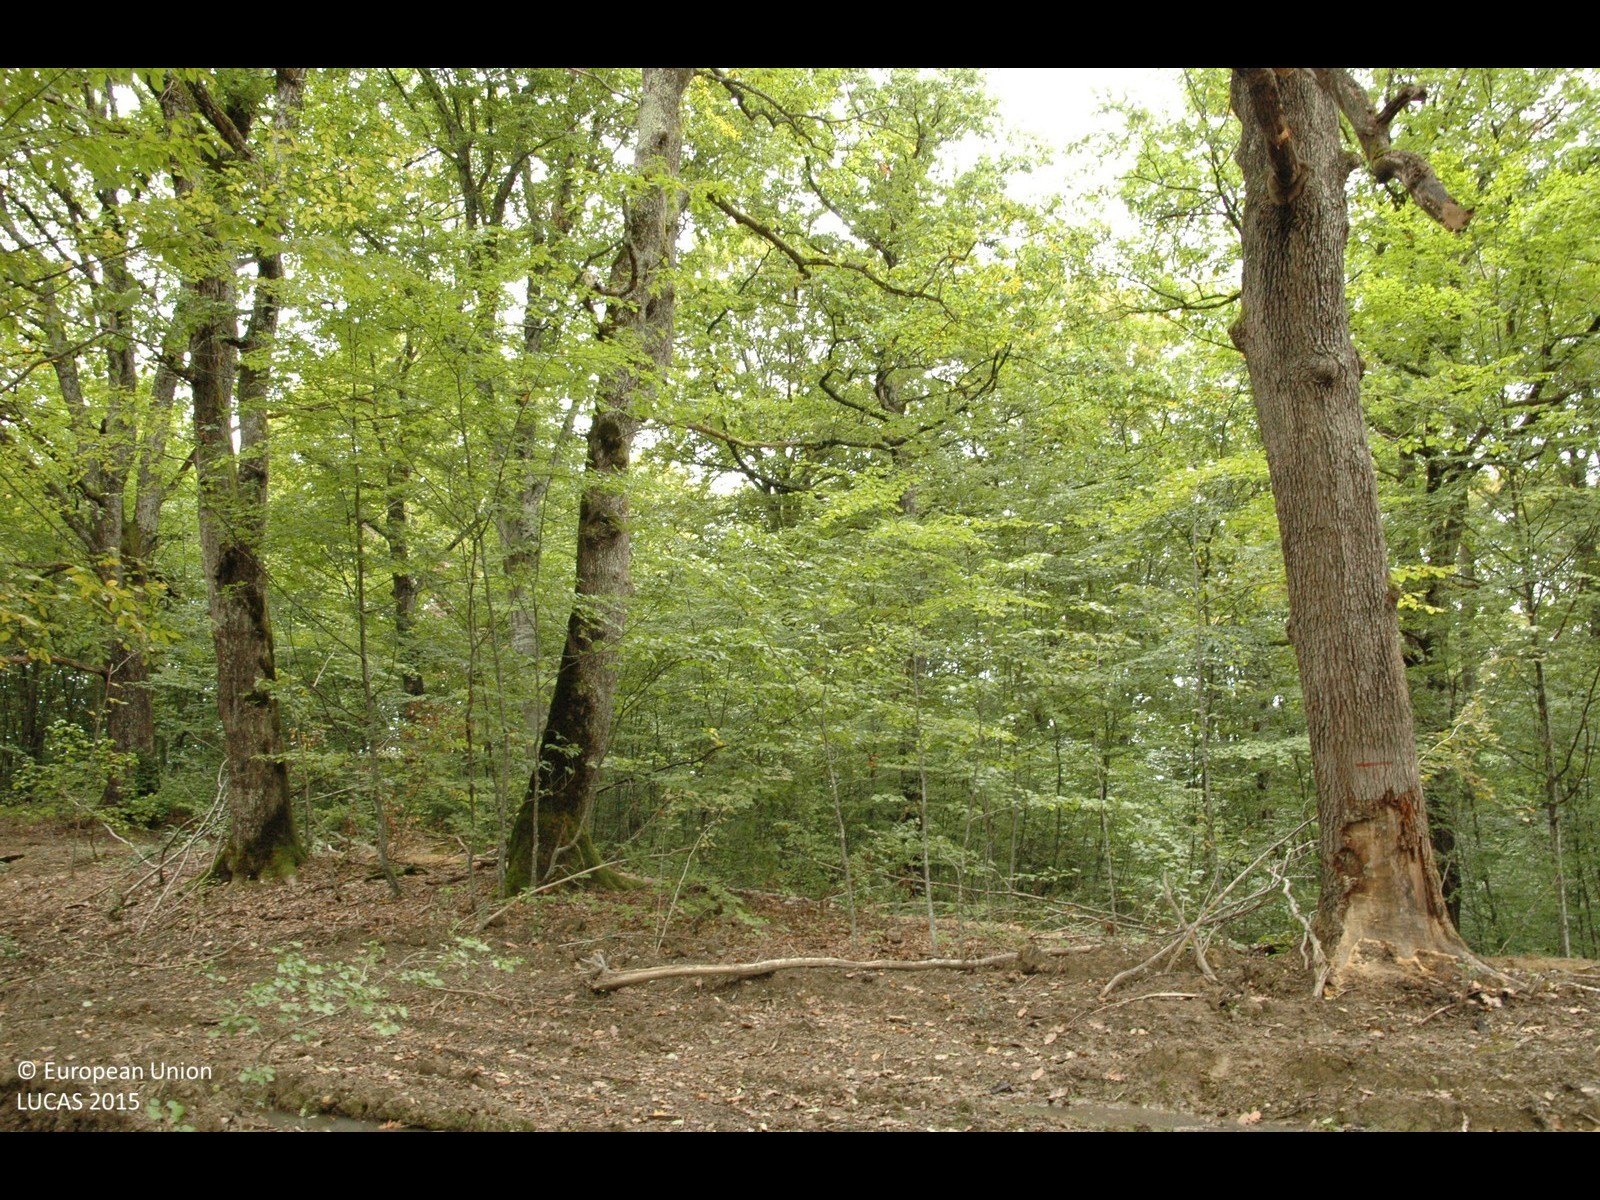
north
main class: Woodland
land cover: Broadleaved woodland
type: mesophytic deciduous forest
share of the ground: > 75 %
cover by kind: broadleaved forest trees 100 %
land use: Forestry
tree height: > 5 m
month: September
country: HR
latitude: 45.2646
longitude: 15.6161
